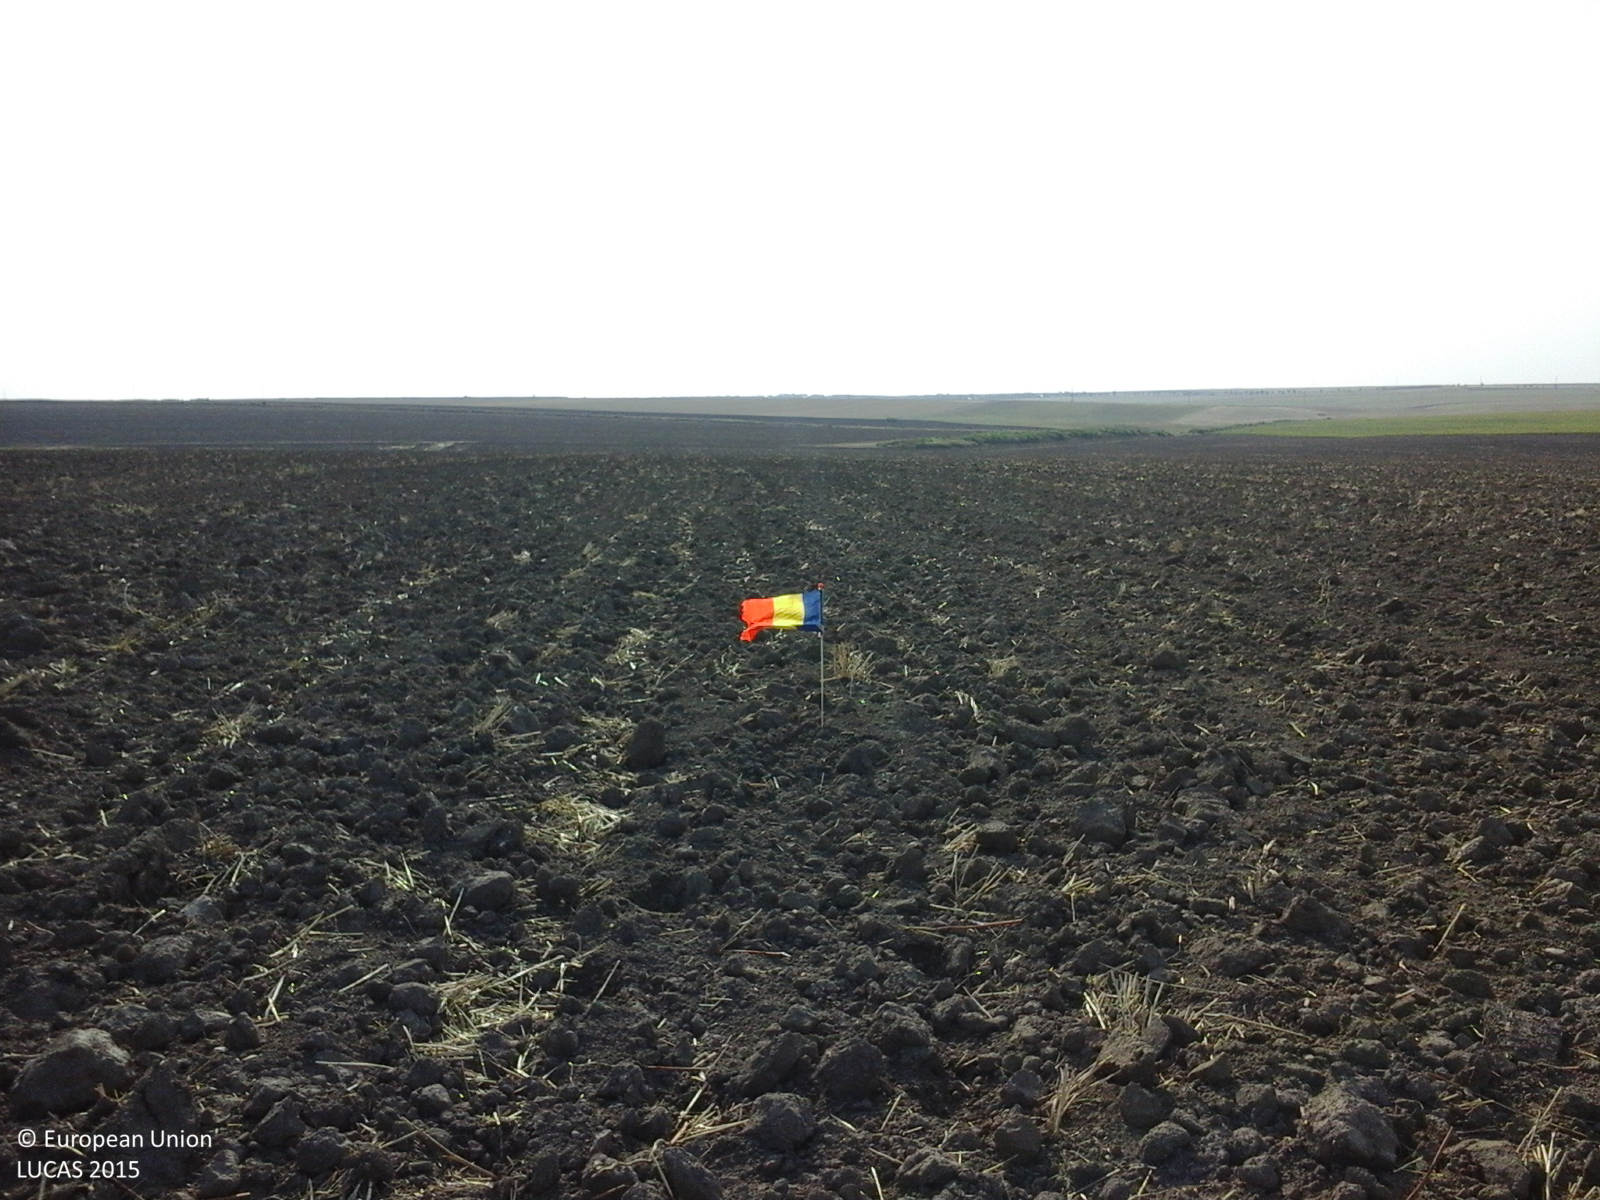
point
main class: Cropland
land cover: Common wheat
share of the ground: < 10 %
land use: Agriculture (excluding fallow land and kitchen gardens)
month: August
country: RO
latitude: 44.1103
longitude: 28.3943
